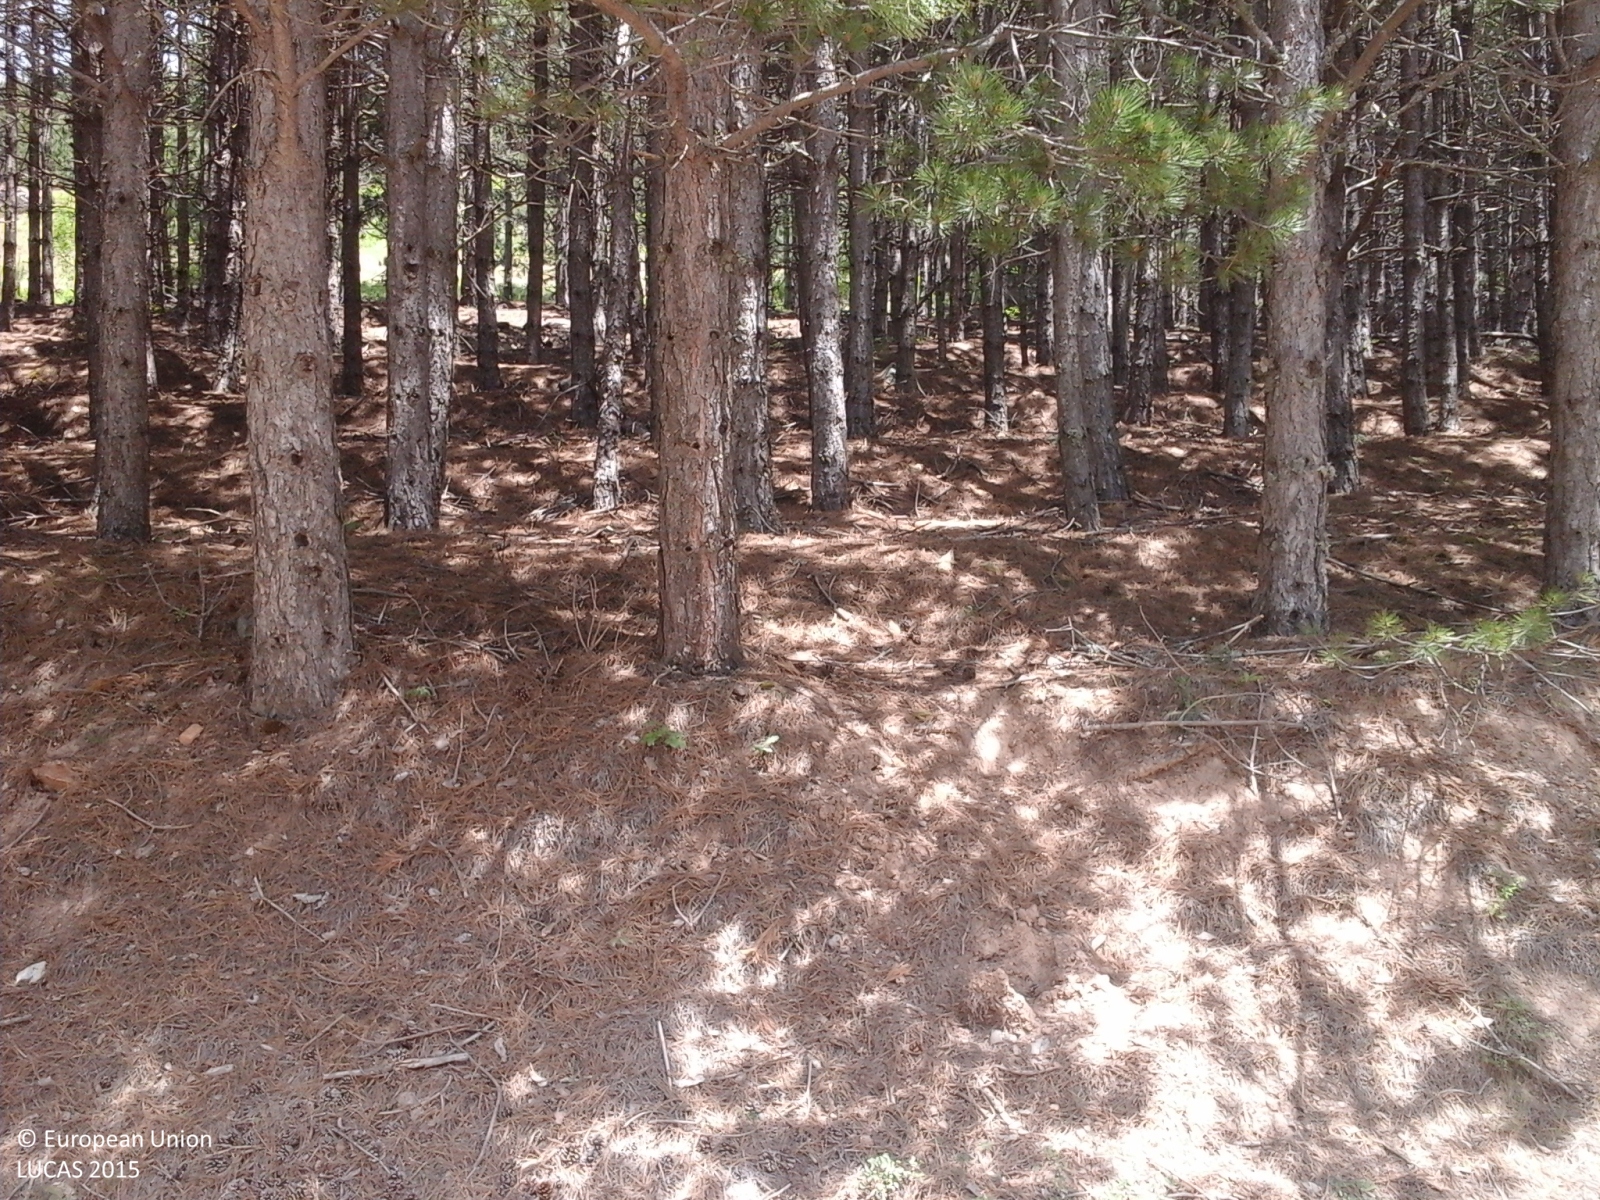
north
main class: Woodland
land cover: Pine dominated coniferous woodland
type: coniferous forest of the mediterranean region
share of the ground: > 75 %
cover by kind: coniferous forest trees 90 %, herbaceous plants 10 %
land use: Forestry
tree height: > 5 m
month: June
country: GR
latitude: 40.6664
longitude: 21.3361
